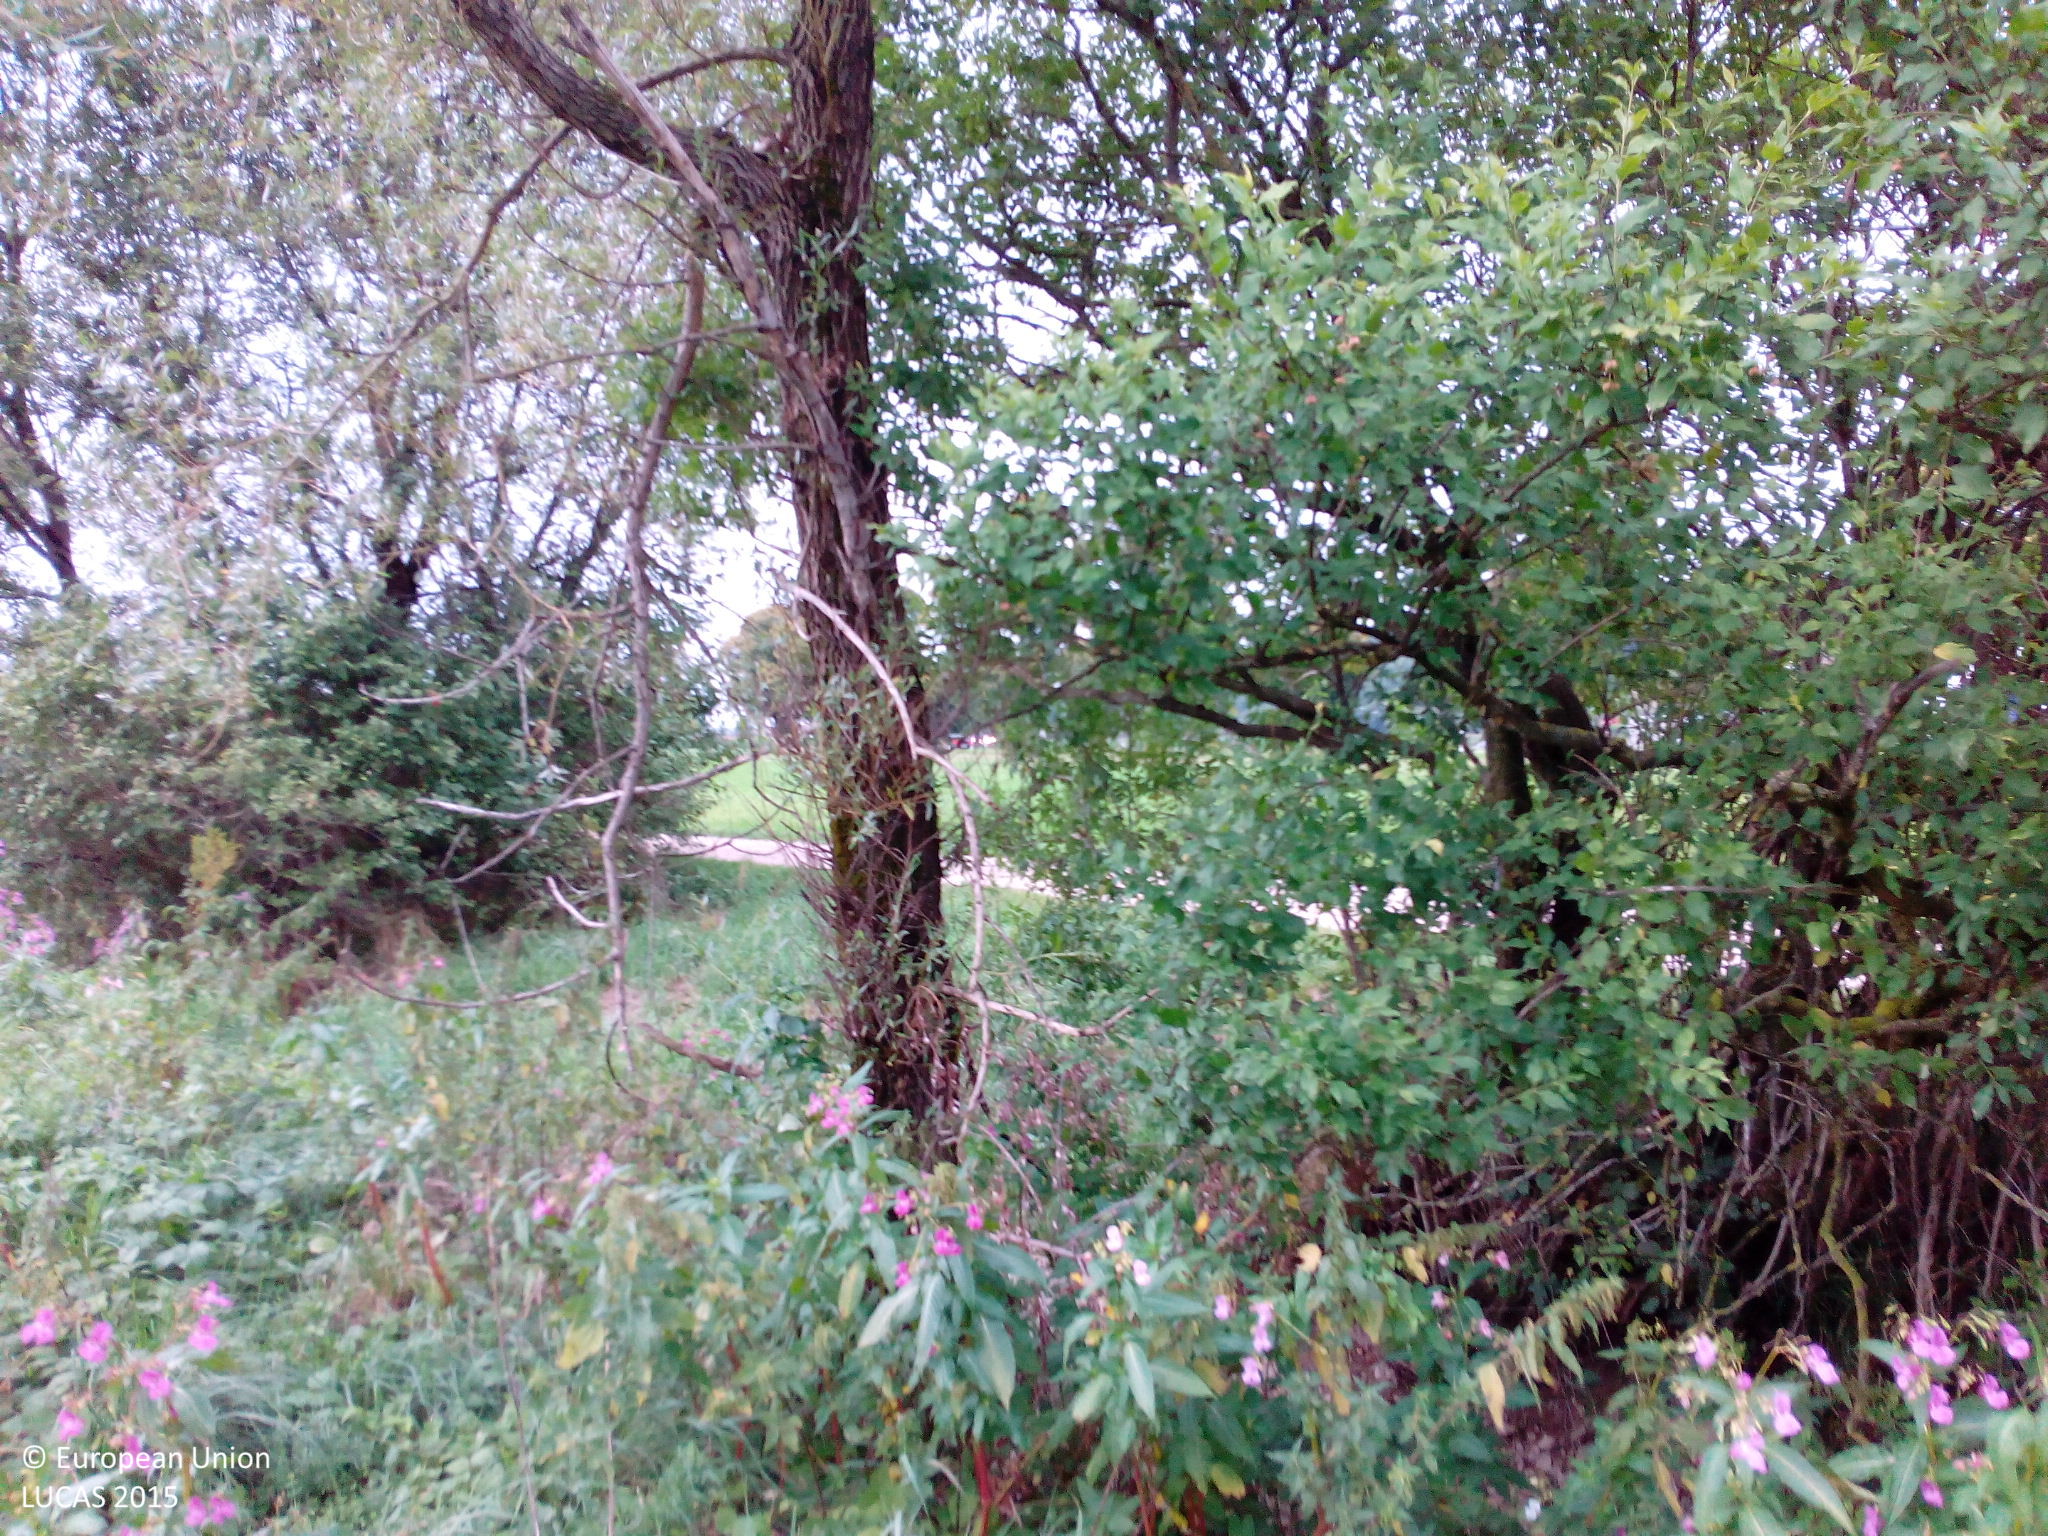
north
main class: Cropland
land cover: Temporary grasslands
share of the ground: 50 - 75 %
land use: Agriculture (excluding fallow land and kitchen gardens)
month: August
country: DE
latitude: 47.7901
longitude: 12.8686
